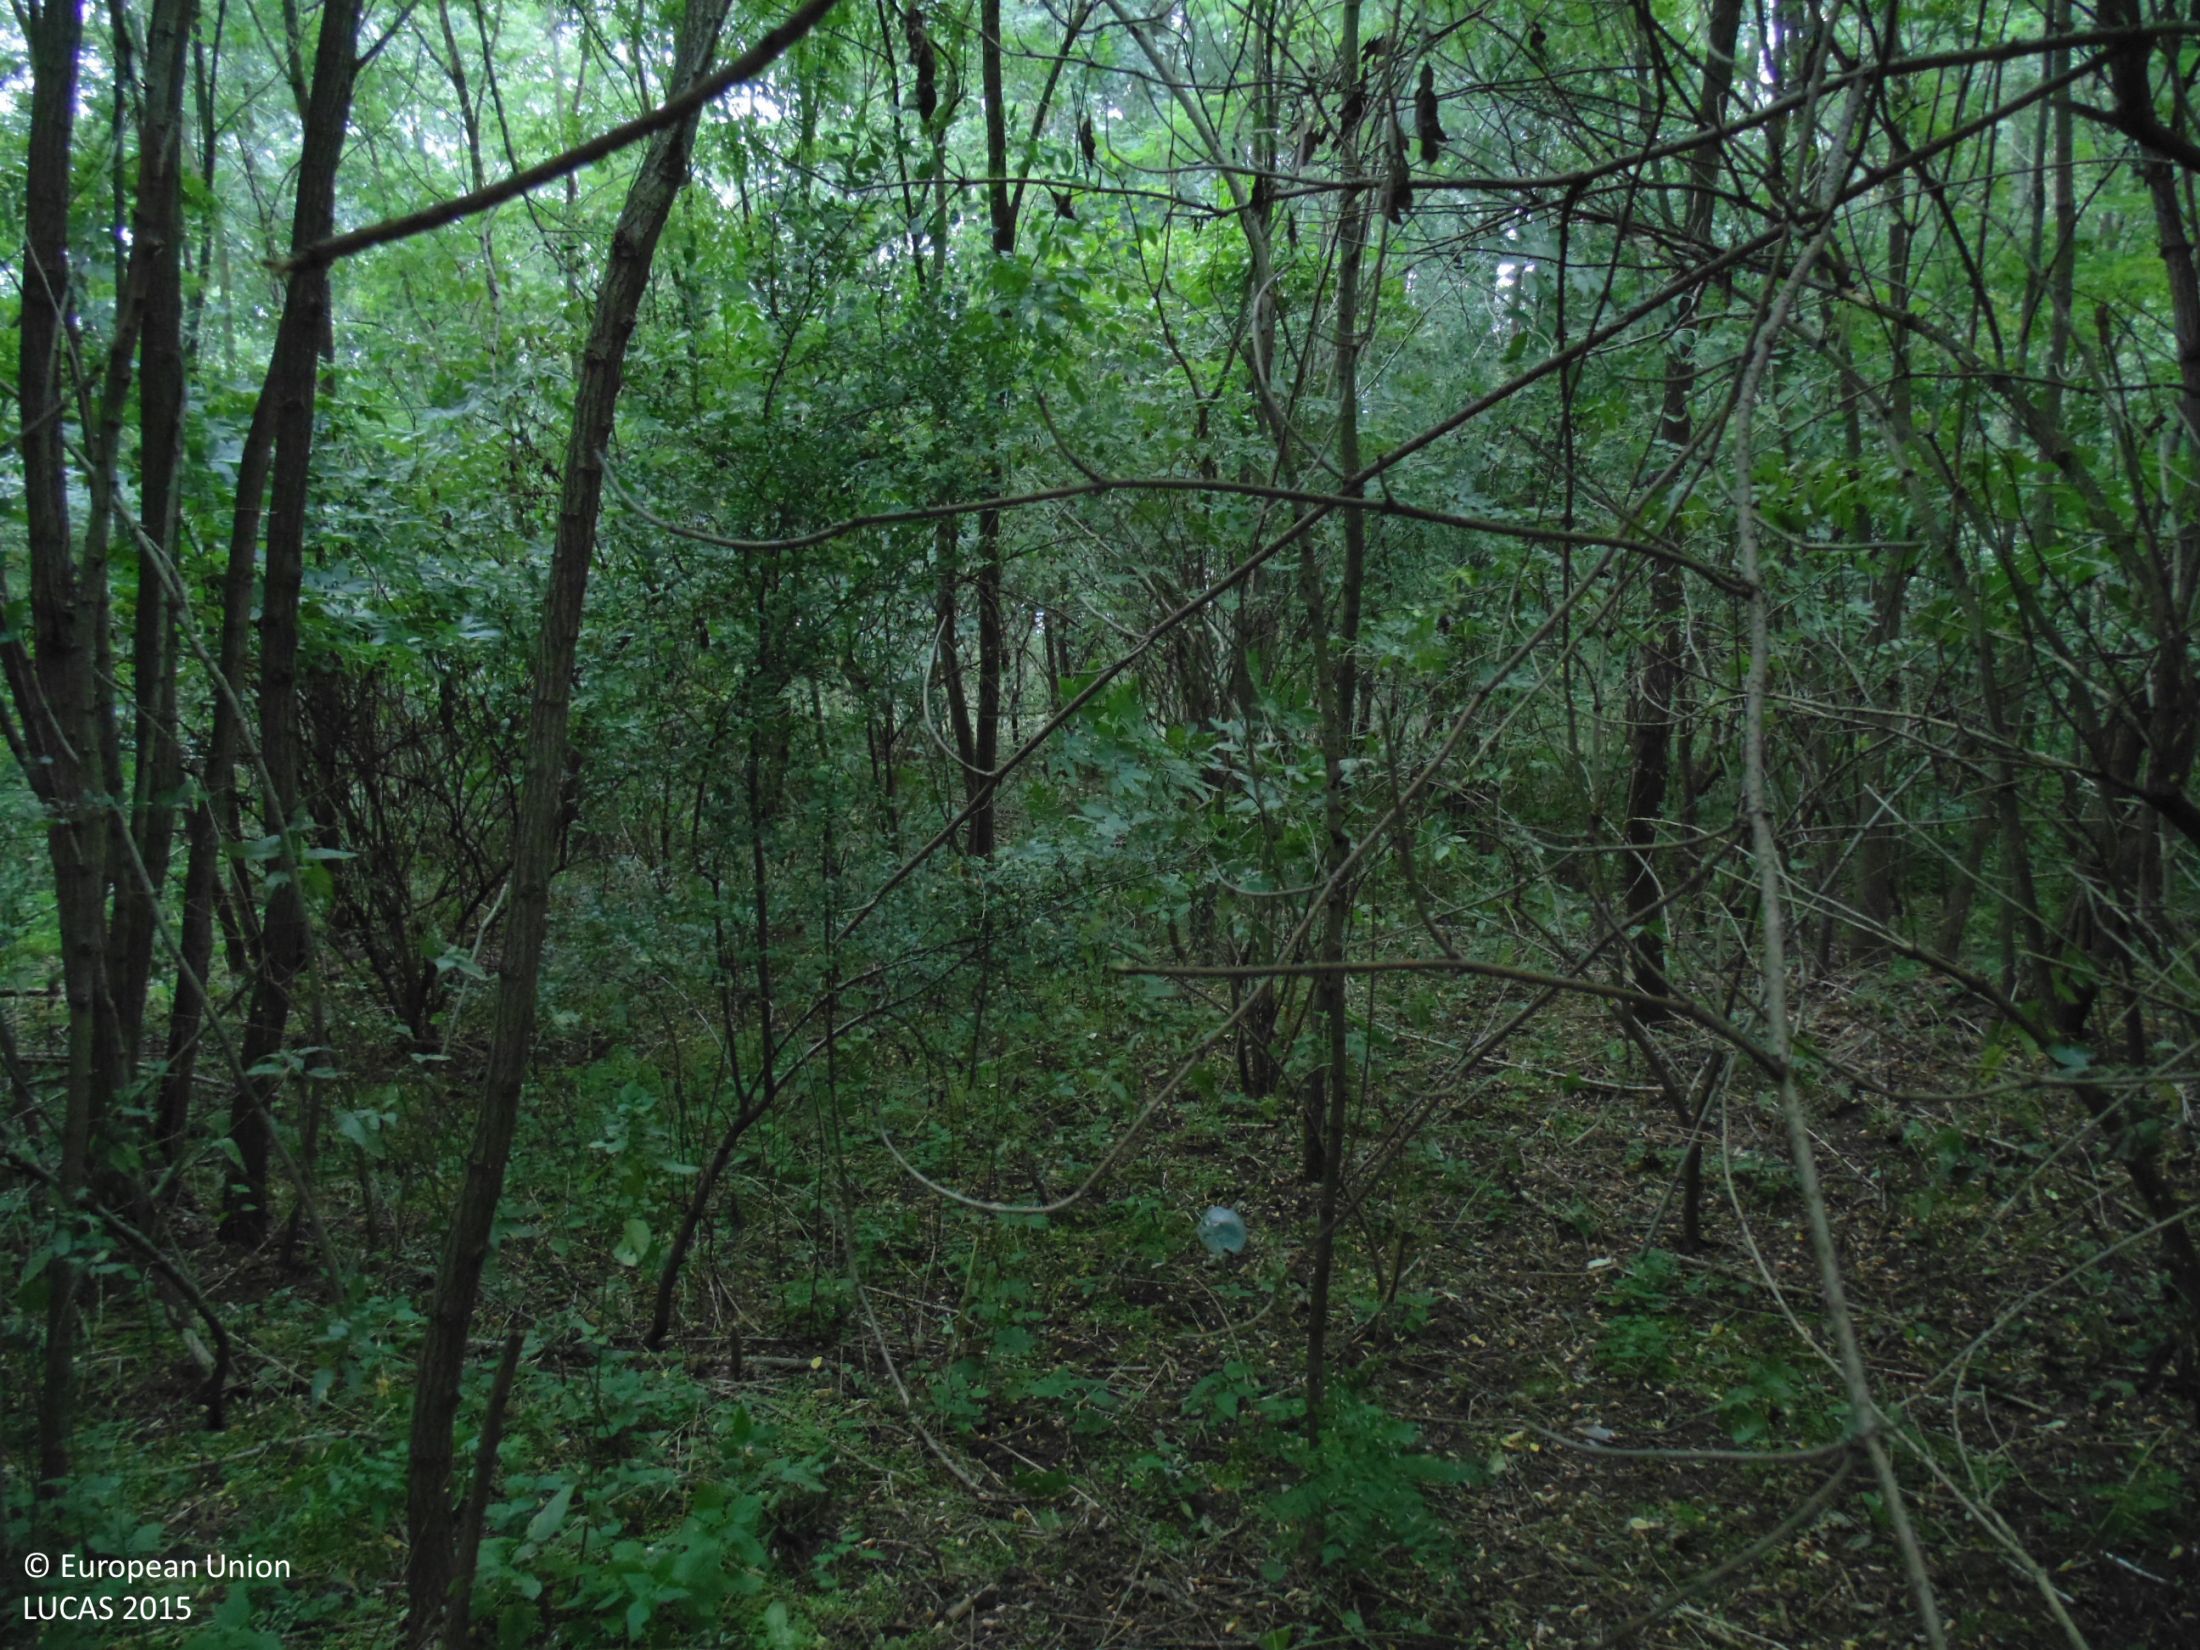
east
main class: Woodland
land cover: Broadleaved woodland
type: mesophytic deciduous forest
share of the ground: > 75 %
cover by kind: broadleaved forest trees 90 %, shrubs 5 %, unconsolidated bare surface 5 %
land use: Forestry
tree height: > 5 m
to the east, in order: Broadleaved woodland; Tracks; Broadleaved woodland; Tracks; Broadleaved woodland; Other bare soil; Inland fresh water bodies
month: September
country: BG
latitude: 44.0245
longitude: 26.9781
